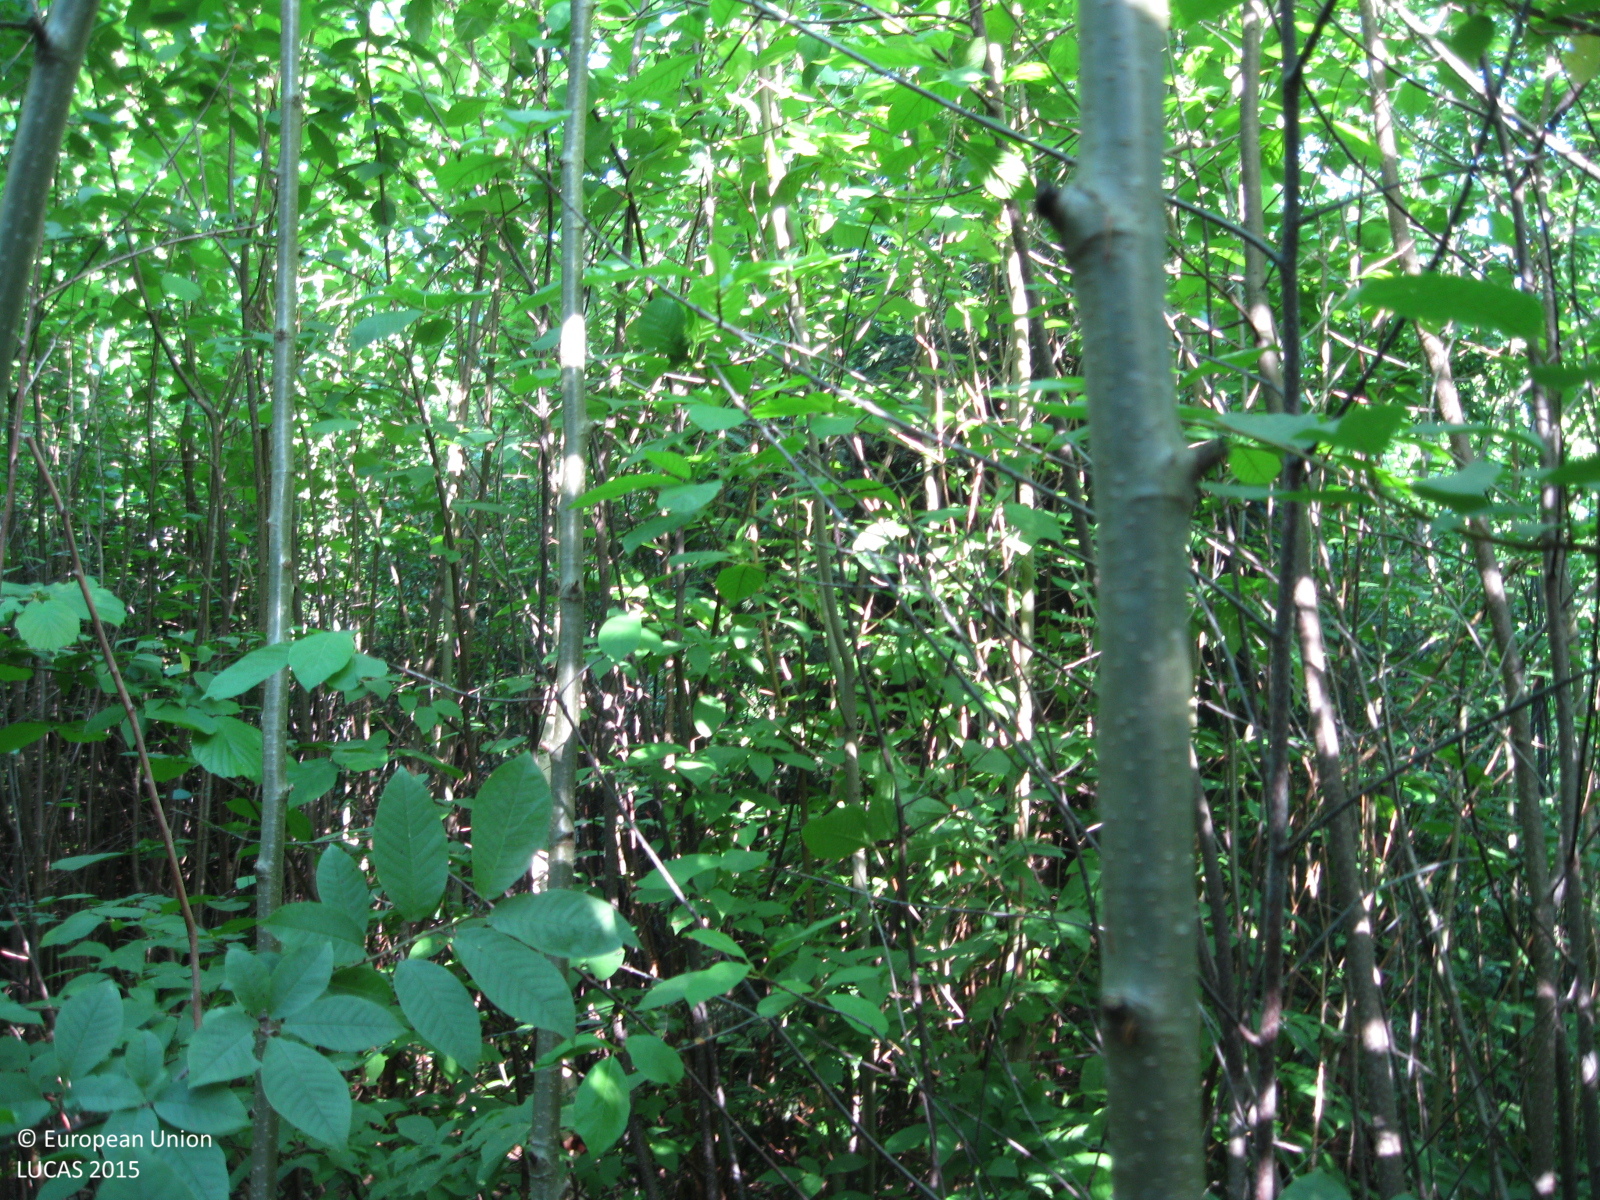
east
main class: Woodland
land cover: Spruce dominated mixed woodland
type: hemiboreal forest and nemoral coniferous forest and mixed broadleaved-coniferous forest
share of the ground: > 75 %
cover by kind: broadleaved forest trees 60 %, coniferous forest trees 30 %, herbaceous plants 10 %
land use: Forestry
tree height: > 5 m
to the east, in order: Spruce dominated mixed woodland; Broadleaved woodland; Triticale
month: June
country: LT
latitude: 55.5678
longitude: 23.6078
